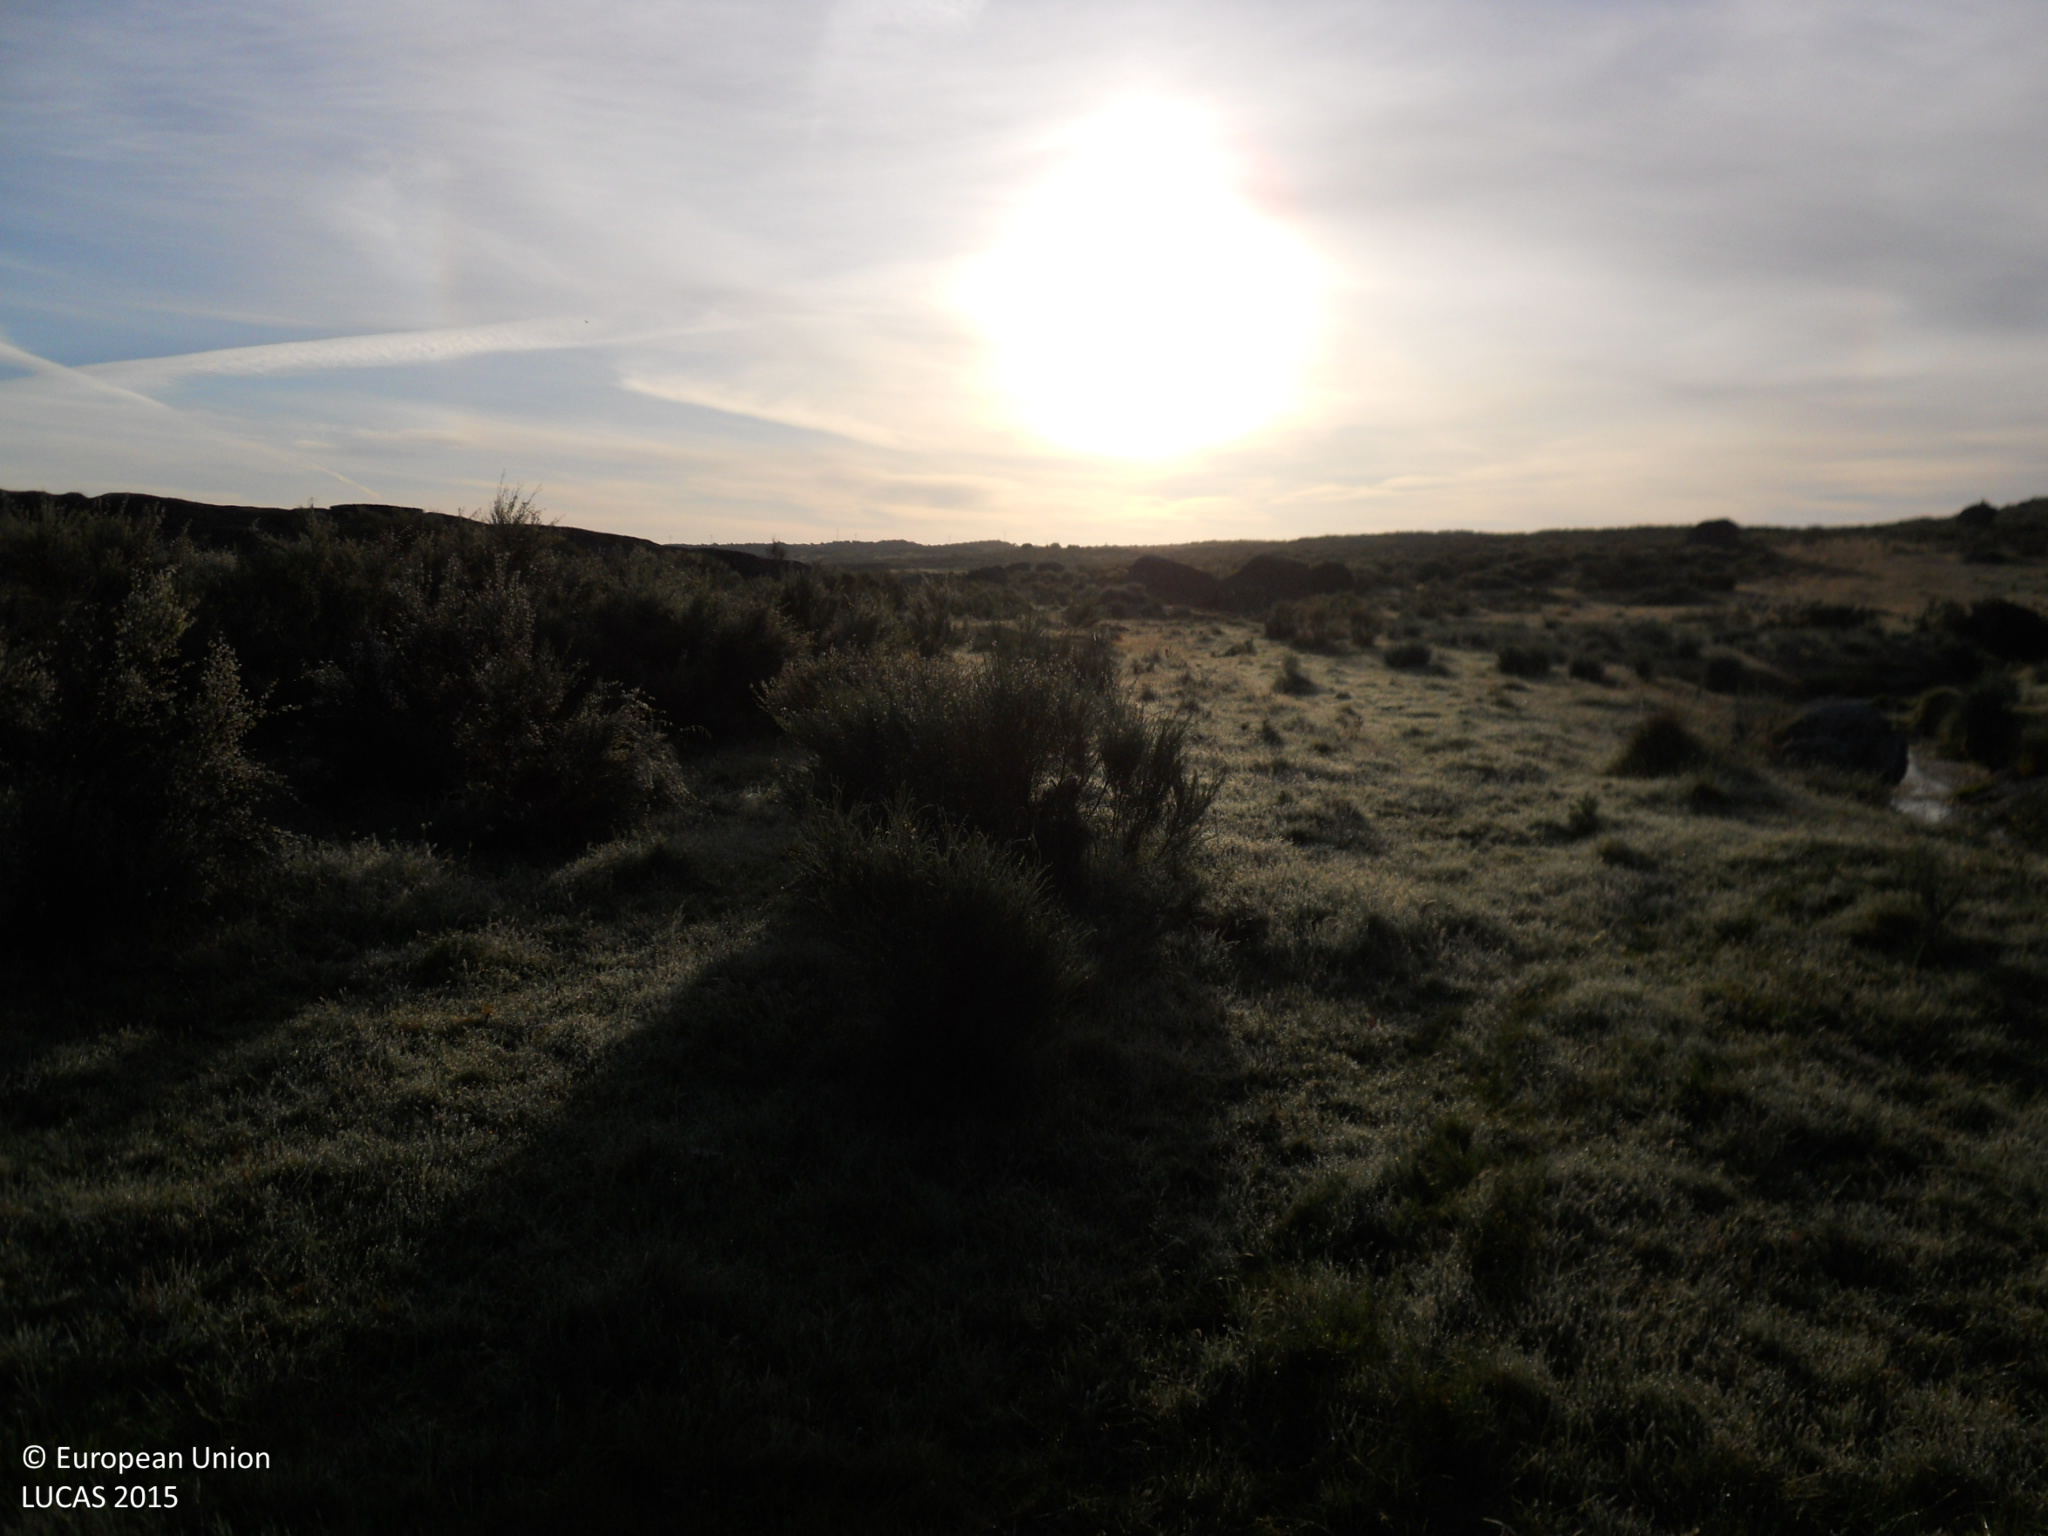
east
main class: Grassland
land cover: Grassland with sparse tree/shrub cover
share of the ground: > 75 %
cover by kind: herbaceous plants 90 %, broadleaved forest trees 5 %, shrubs 5 %
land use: Agriculture (excluding fallow land and kitchen gardens)
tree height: < 5 m
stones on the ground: 10 - 25 %
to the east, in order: Grassland with sparse tree/shrub cover; Rock outcrops; Rivers and streams; Grassland with sparse tree/shrub cover; Rock outcrops; Grassland with sparse tree/shrub cover
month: April
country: ES
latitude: 39.2769
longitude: -7.0614
